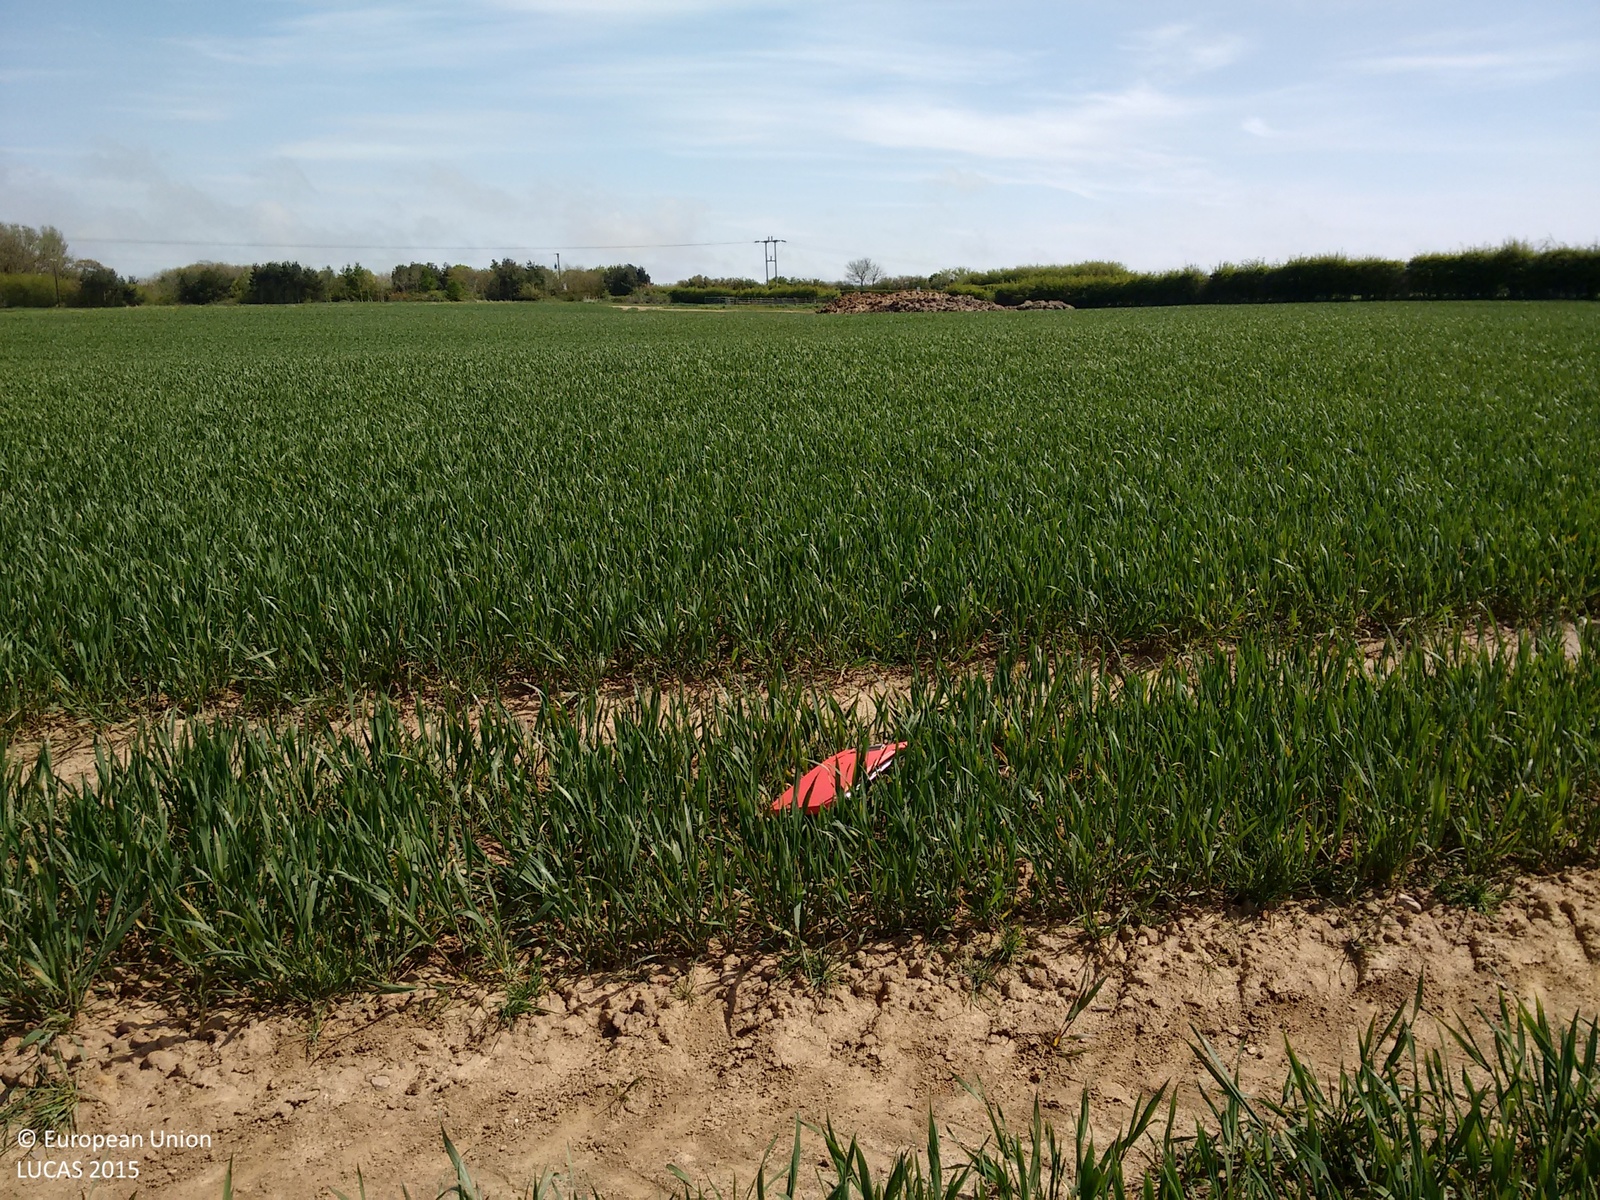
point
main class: Cropland
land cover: Common wheat
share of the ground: > 75 %
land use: Agriculture (excluding fallow land and kitchen gardens)
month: May
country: GB
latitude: 53.9265
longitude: -0.2524
